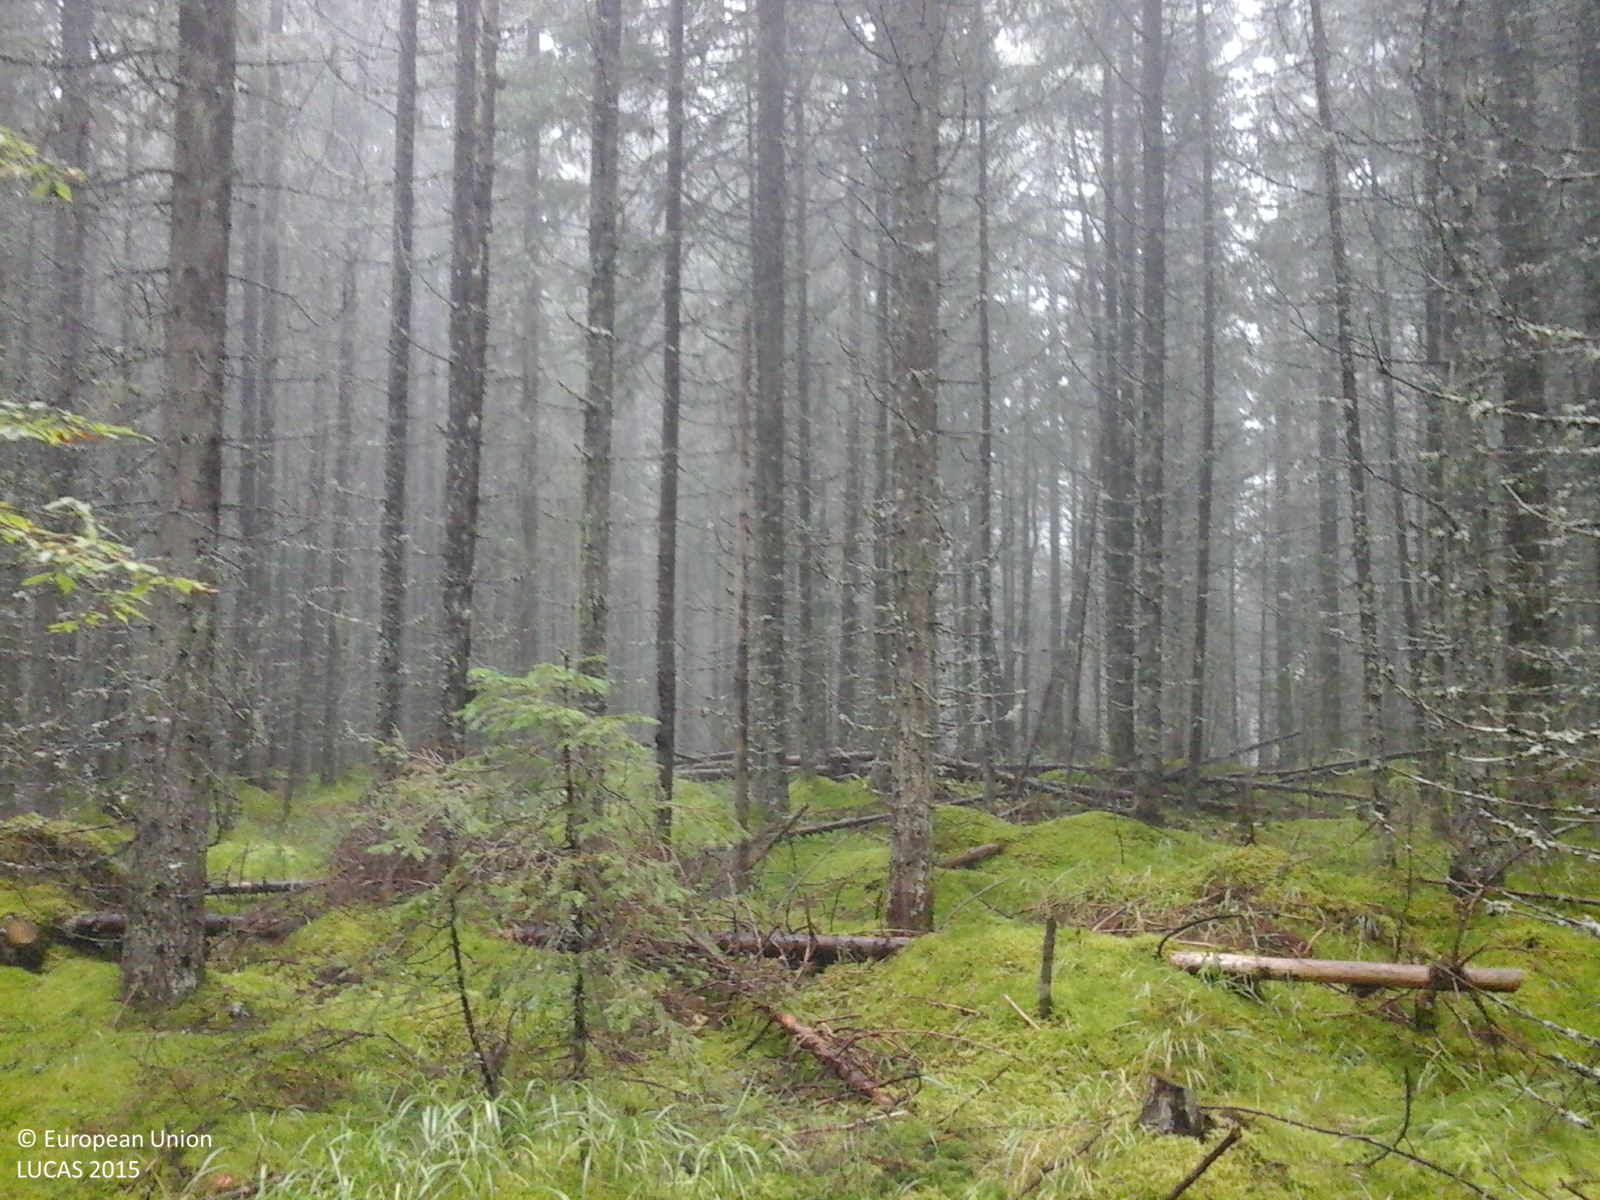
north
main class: Woodland
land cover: Spruce dominated coniferous woodland
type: alpine coniferous forest
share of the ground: > 75 %
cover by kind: coniferous forest trees 90 %, herbaceous plants 10 %
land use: Forestry
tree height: > 5 m
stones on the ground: > 50 %
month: September
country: RO
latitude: 45.6433
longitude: 23.7303
